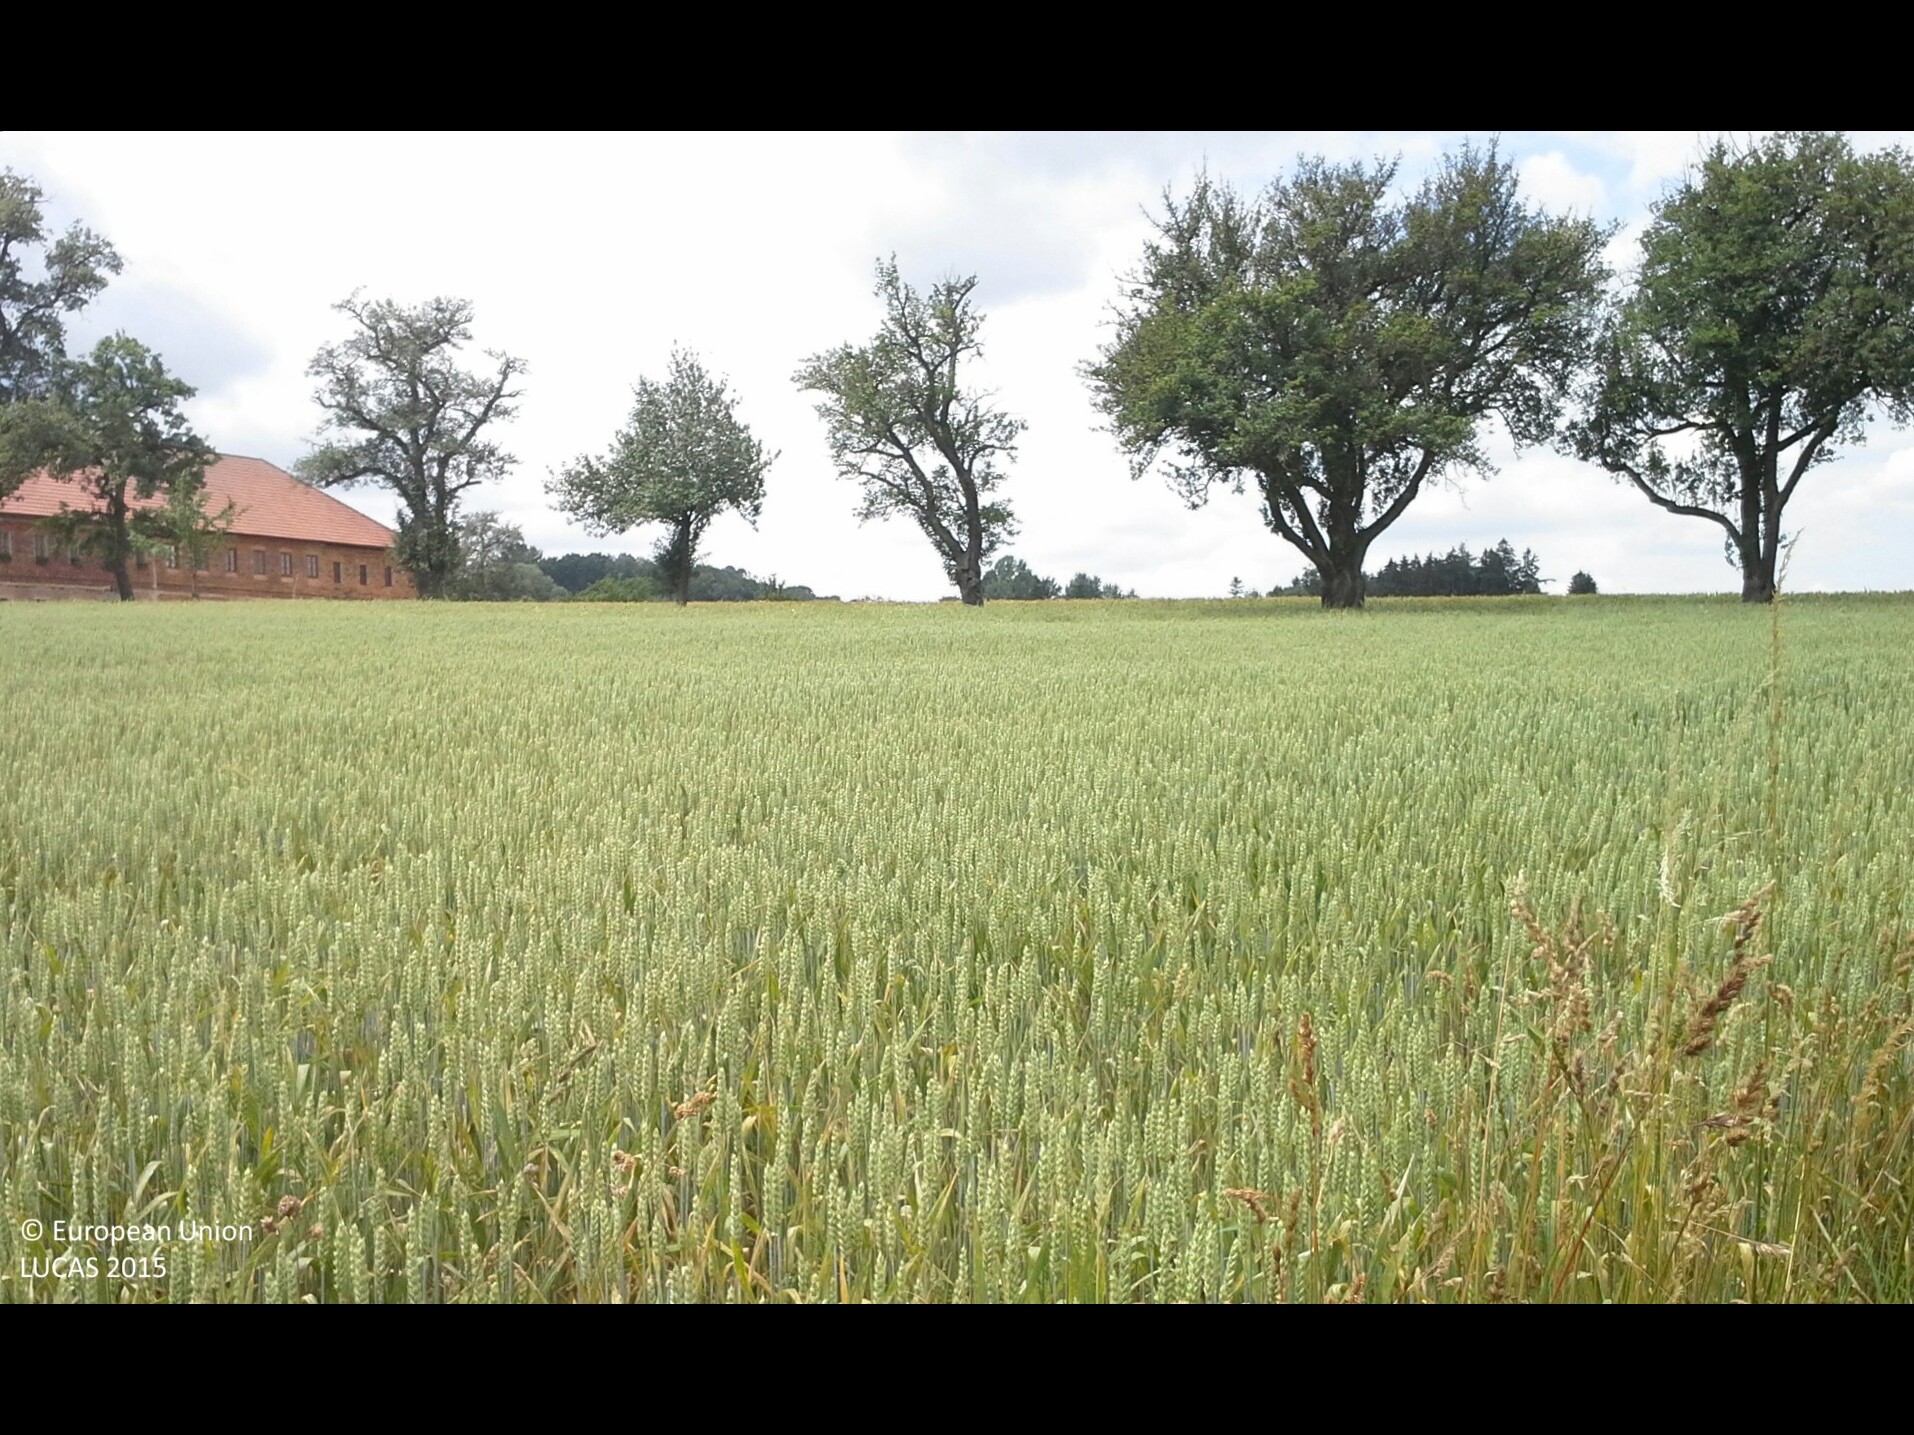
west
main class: Cropland
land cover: Common wheat
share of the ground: > 75 %
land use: Agriculture (excluding fallow land and kitchen gardens)
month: June
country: AT
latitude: 48.0374
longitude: 14.6006
